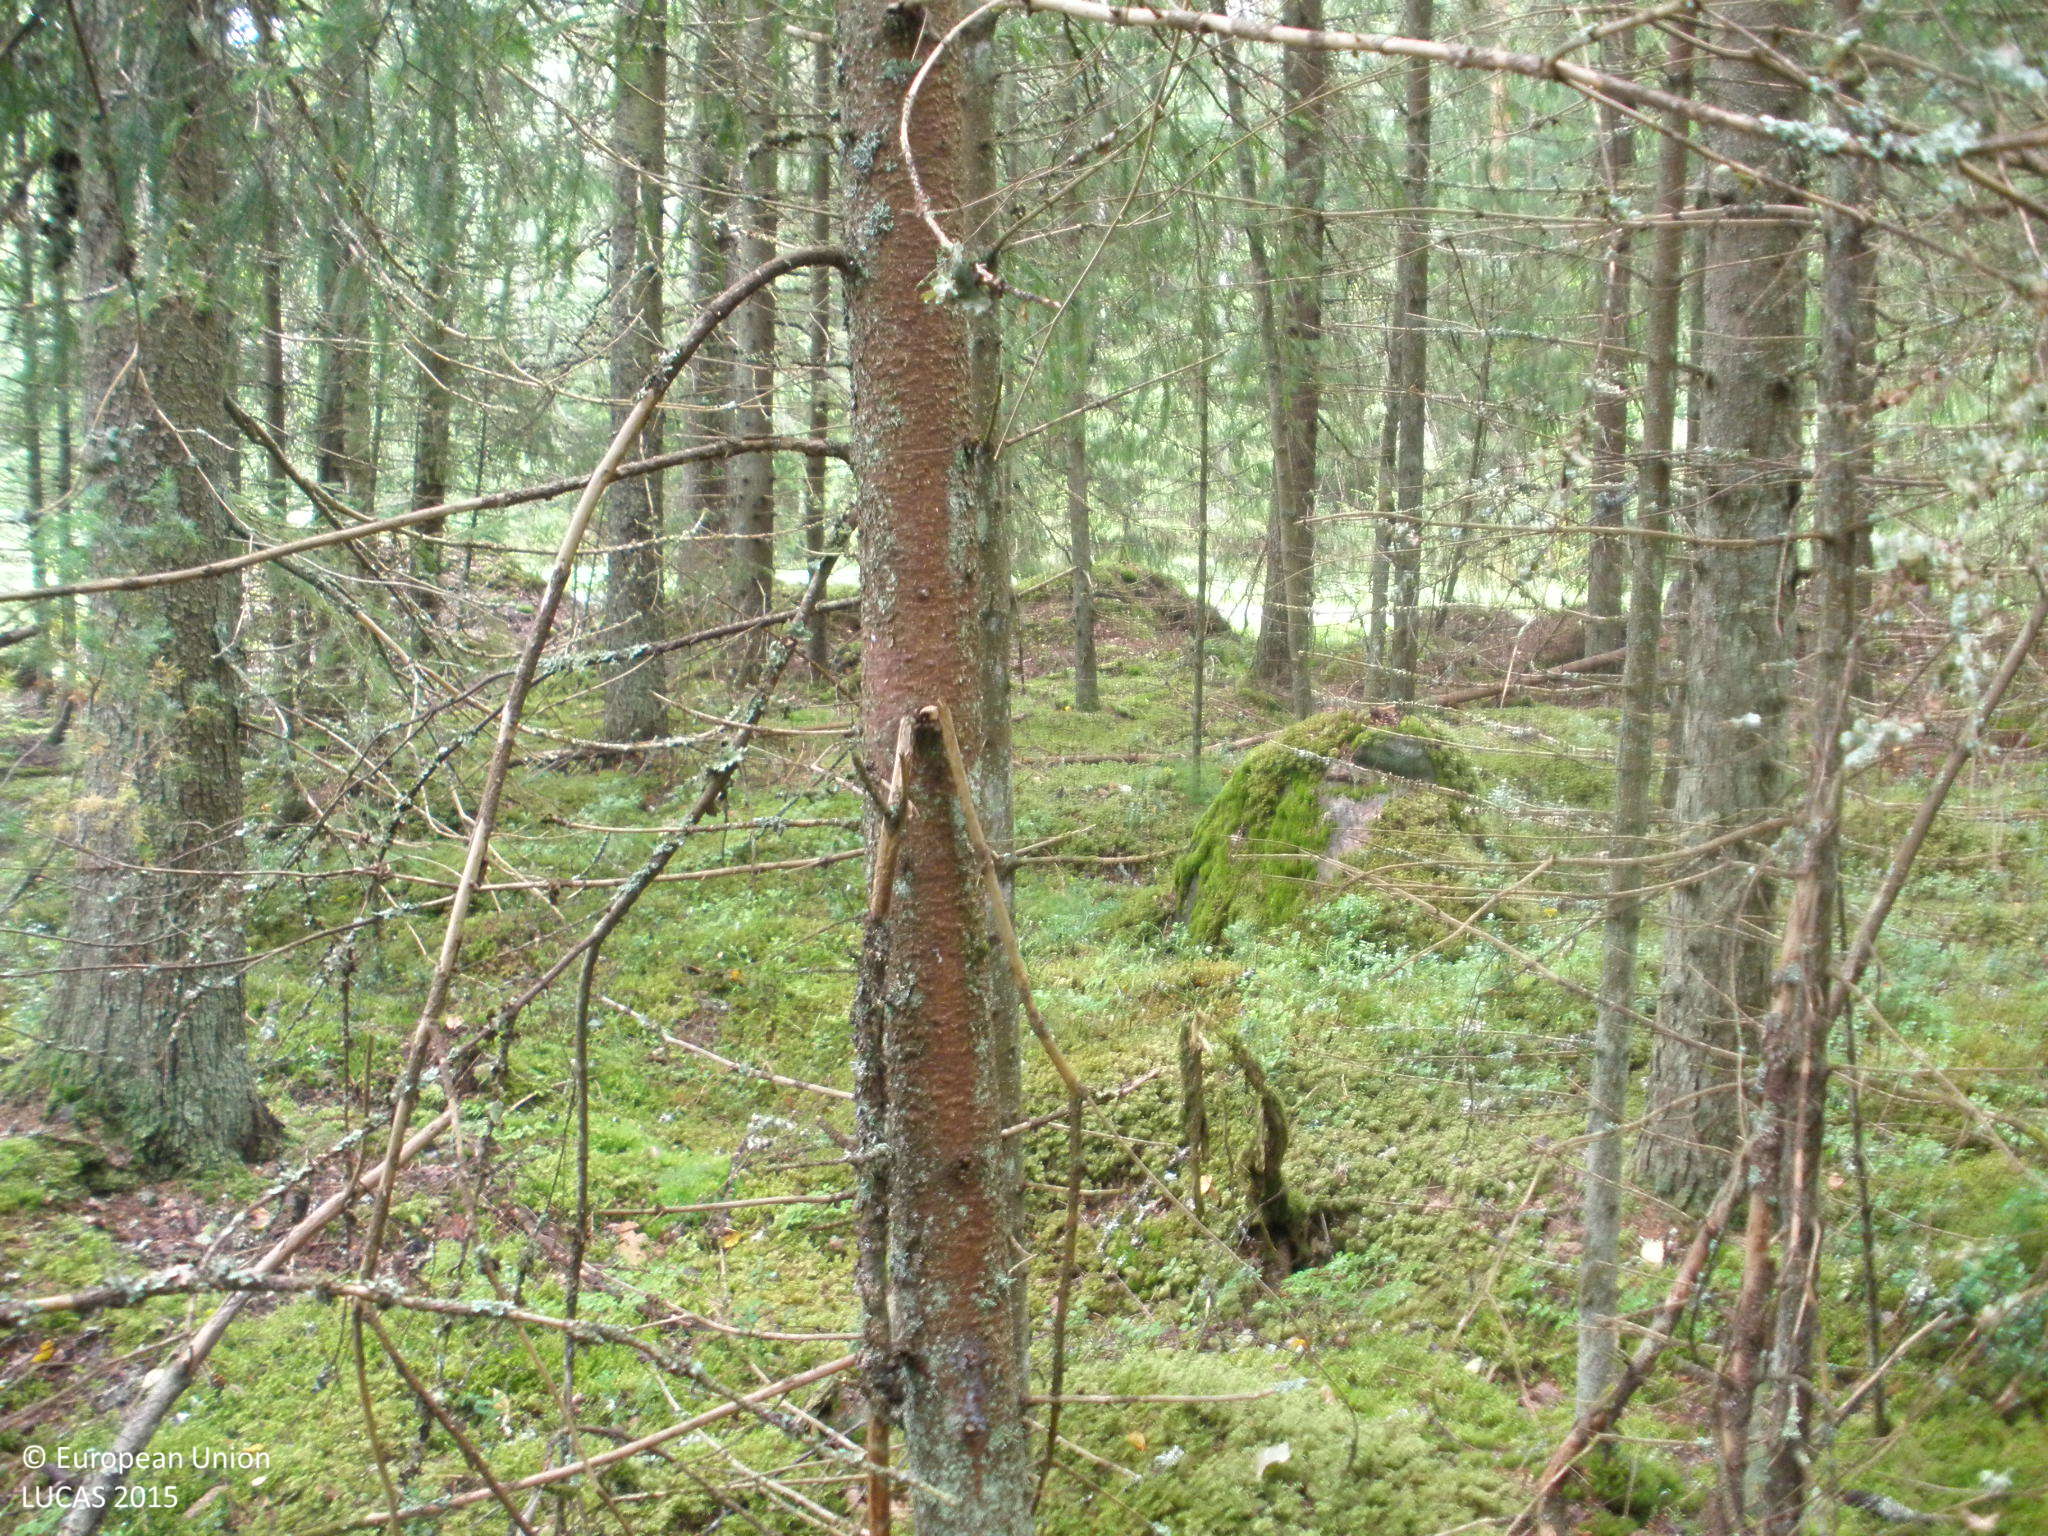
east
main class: Woodland
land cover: Spruce dominated coniferous woodland
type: boreal forest
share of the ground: > 75 %
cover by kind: coniferous forest trees 95 %, lichens and mosses 5 %
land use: Forestry
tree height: > 5 m
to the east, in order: Spruce dominated coniferous woodland; Ditches and canals; Grass margins; Tracks; Grass margins; Ditches and canals; Spruce dominated mixed woodland; Ditches and canals; Rape and turnip rape
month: July
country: FI
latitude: 60.6732
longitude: 23.3899
